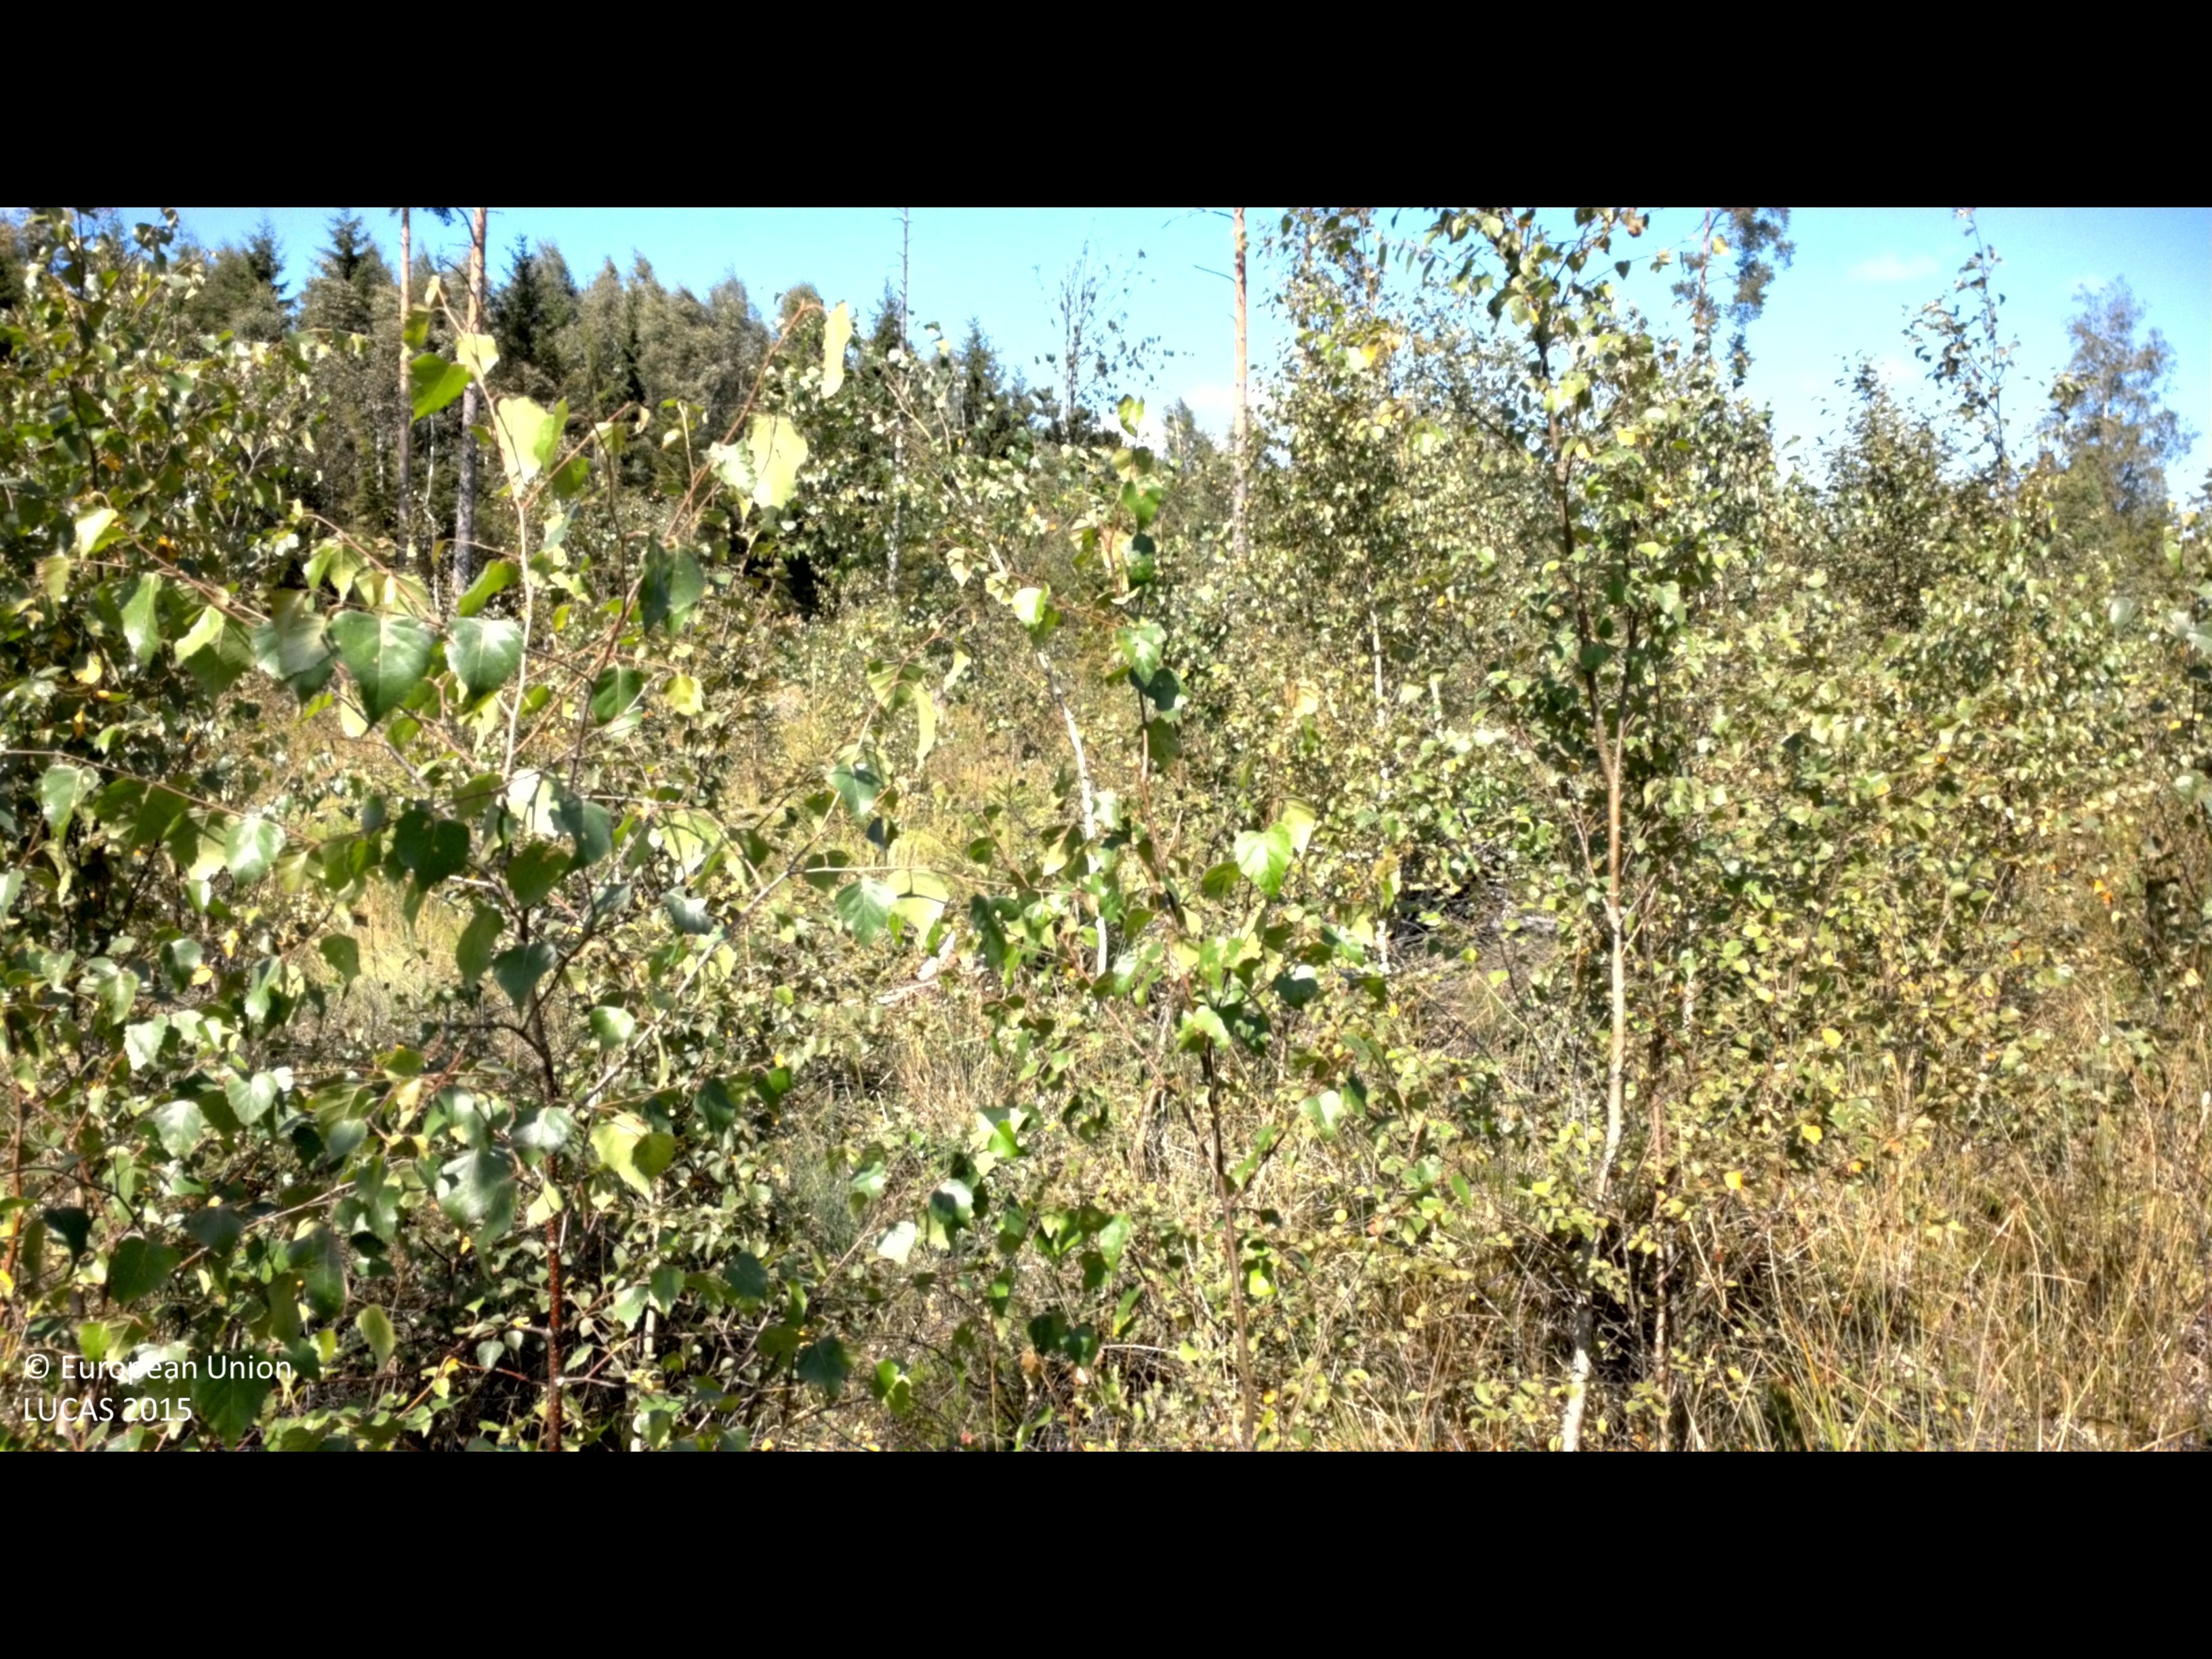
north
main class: Woodland
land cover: Broadleaved woodland
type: boreal forest
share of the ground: 50 - 75 %
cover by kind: broadleaved forest trees 55 %, shrubs 20 %, herbaceous plants 15 %, coniferous forest trees 10 %
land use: Forestry
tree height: < 5 m
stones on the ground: 10 - 25 %
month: August
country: SE
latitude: 56.9776
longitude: 13.7969
